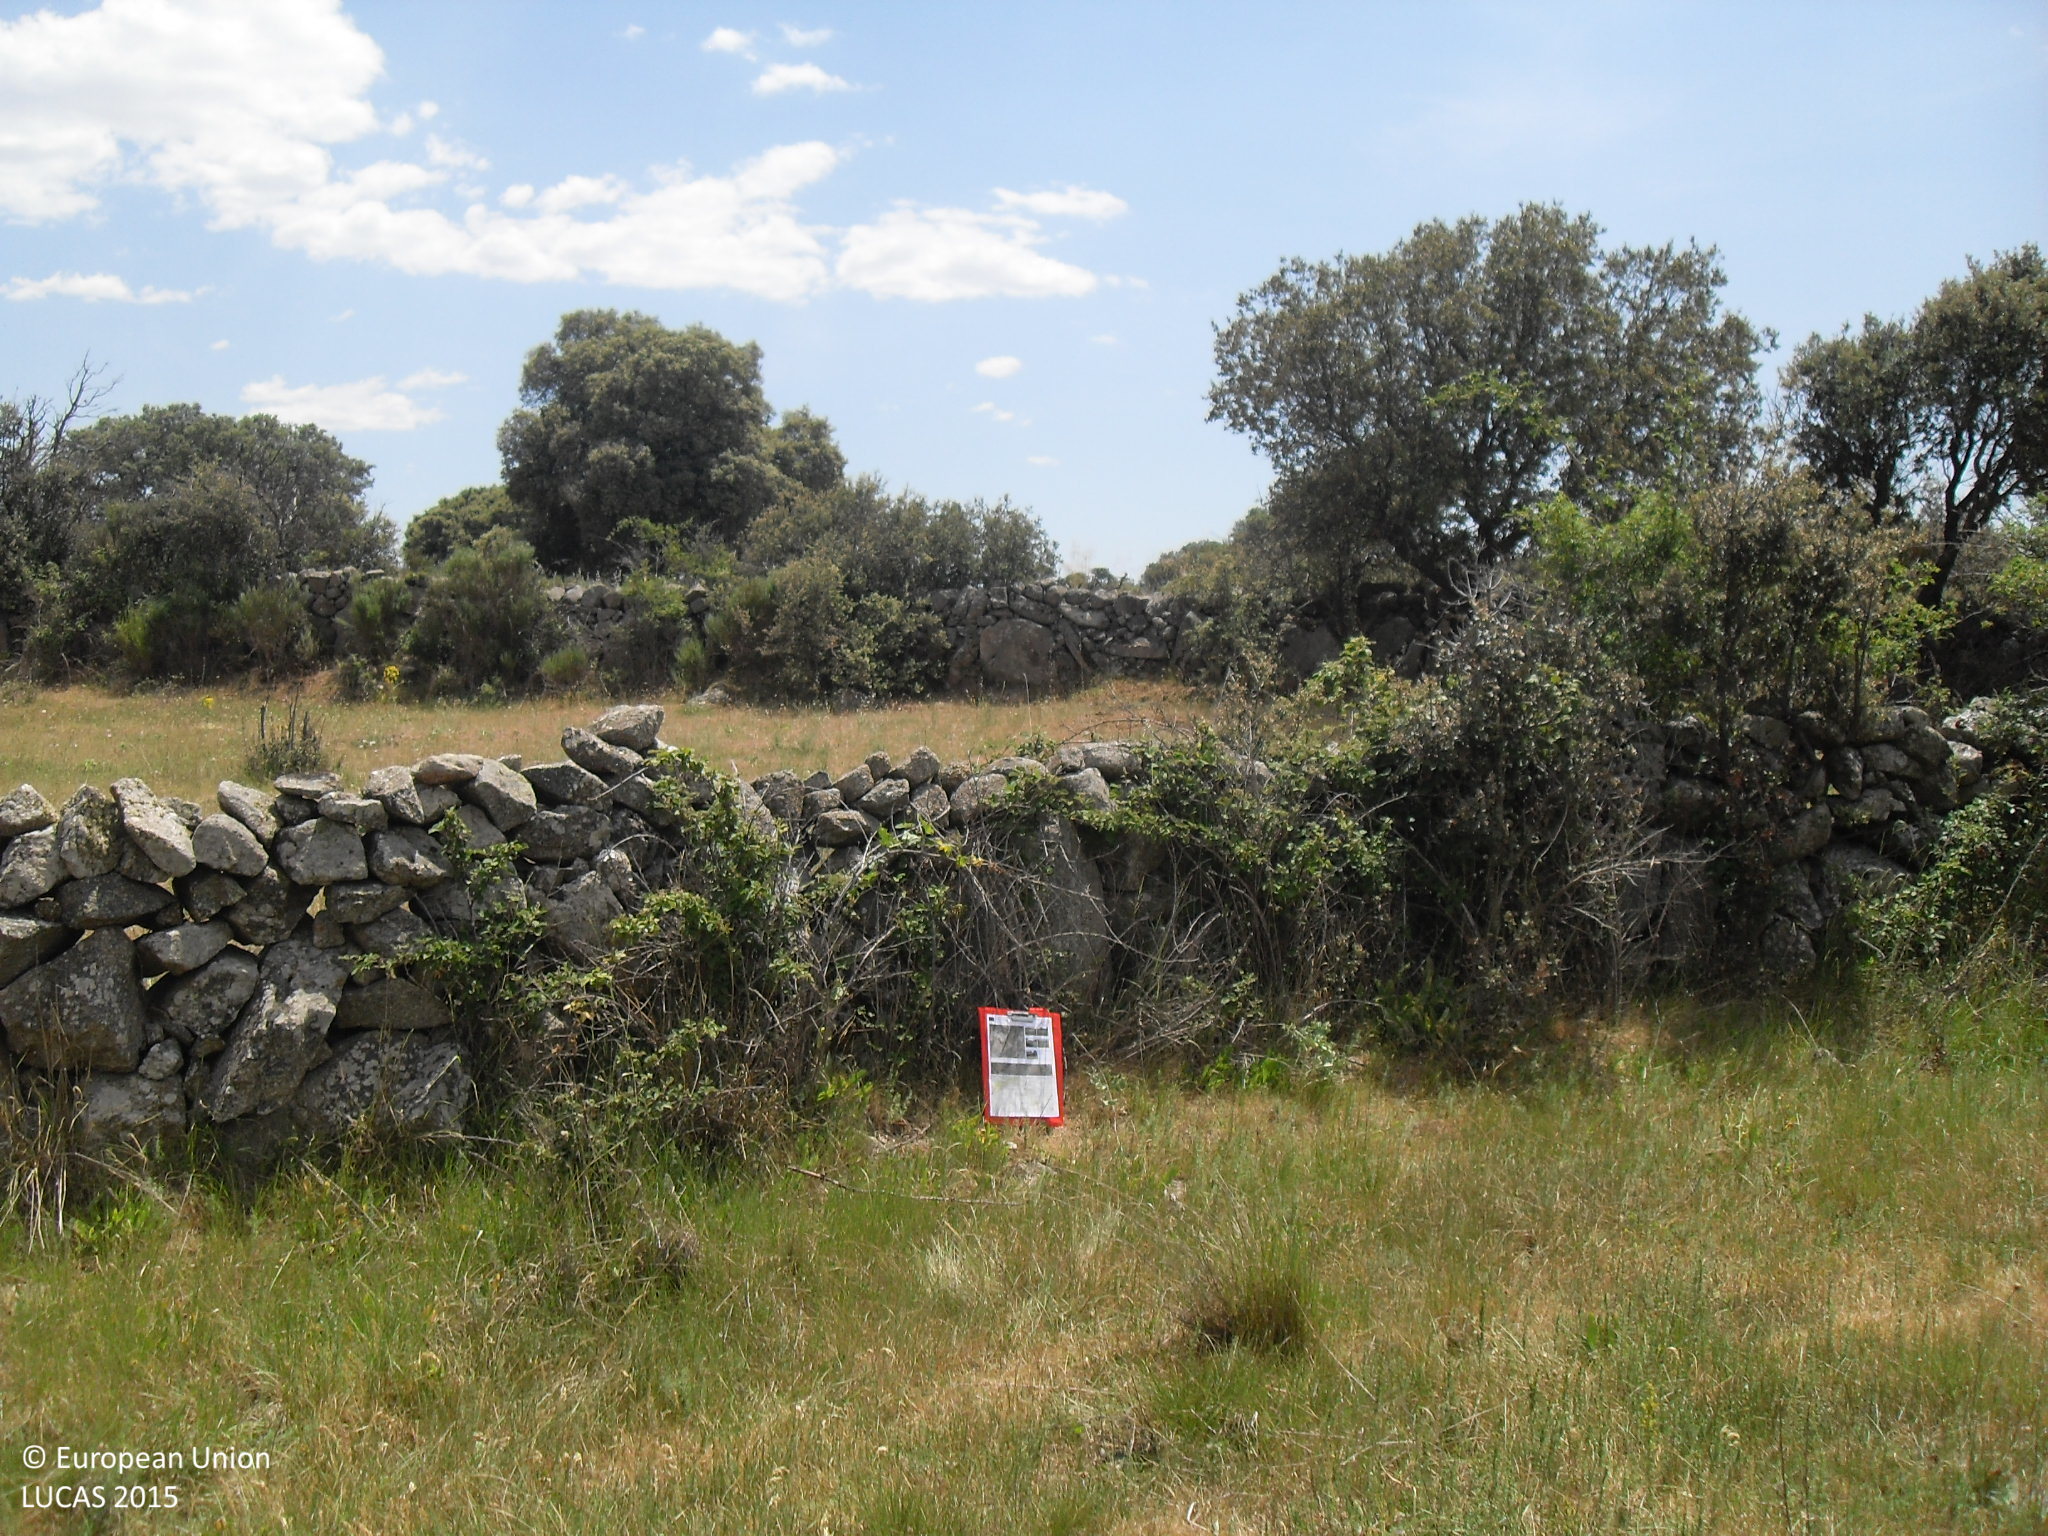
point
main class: Grassland
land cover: Grassland without tree/shrub cover
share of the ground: > 75 %
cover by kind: herbaceous plants 100 %
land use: Agriculture (excluding fallow land and kitchen gardens)
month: June
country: ES
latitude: 40.4351
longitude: -5.5454
